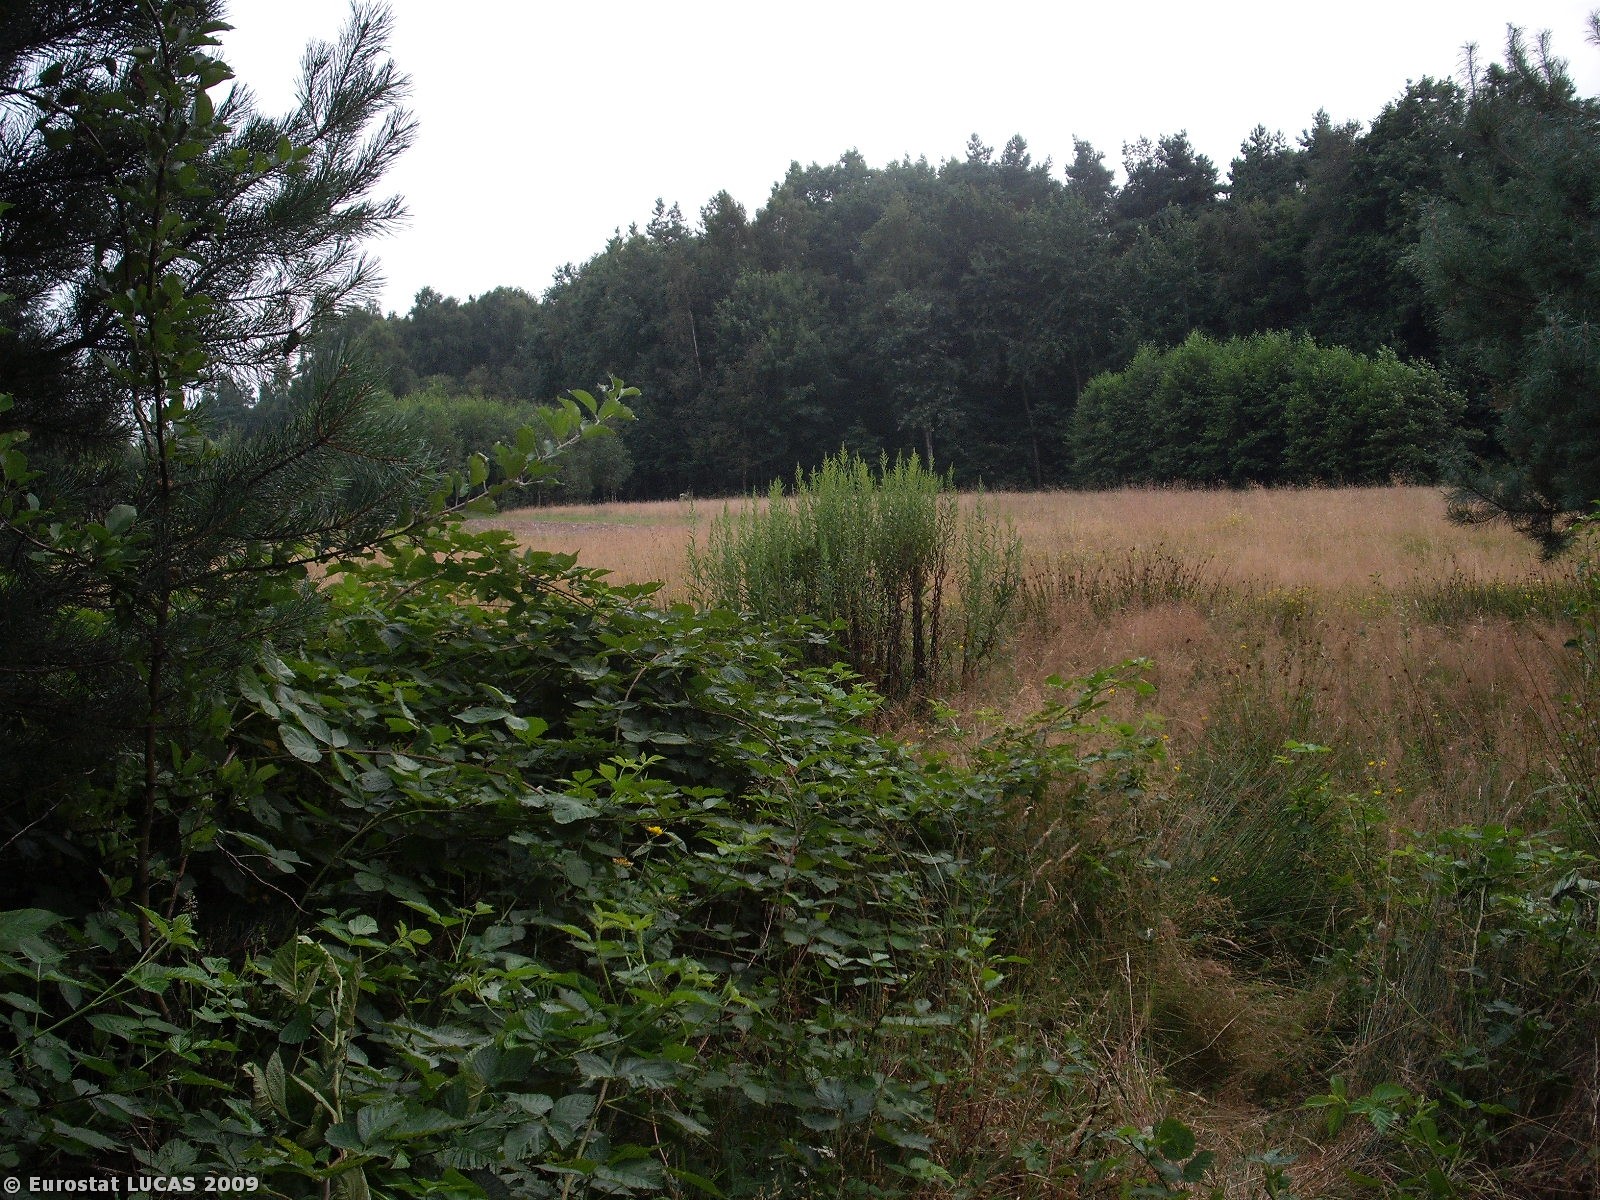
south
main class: Woodland
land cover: Mixed woodland
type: hemiboreal forest and nemoral coniferous forest and mixed broadleaved-coniferous forest
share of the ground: > 75 %
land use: Unused
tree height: > 5 m
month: August
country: PL
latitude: 50.0354
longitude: 21.1448
